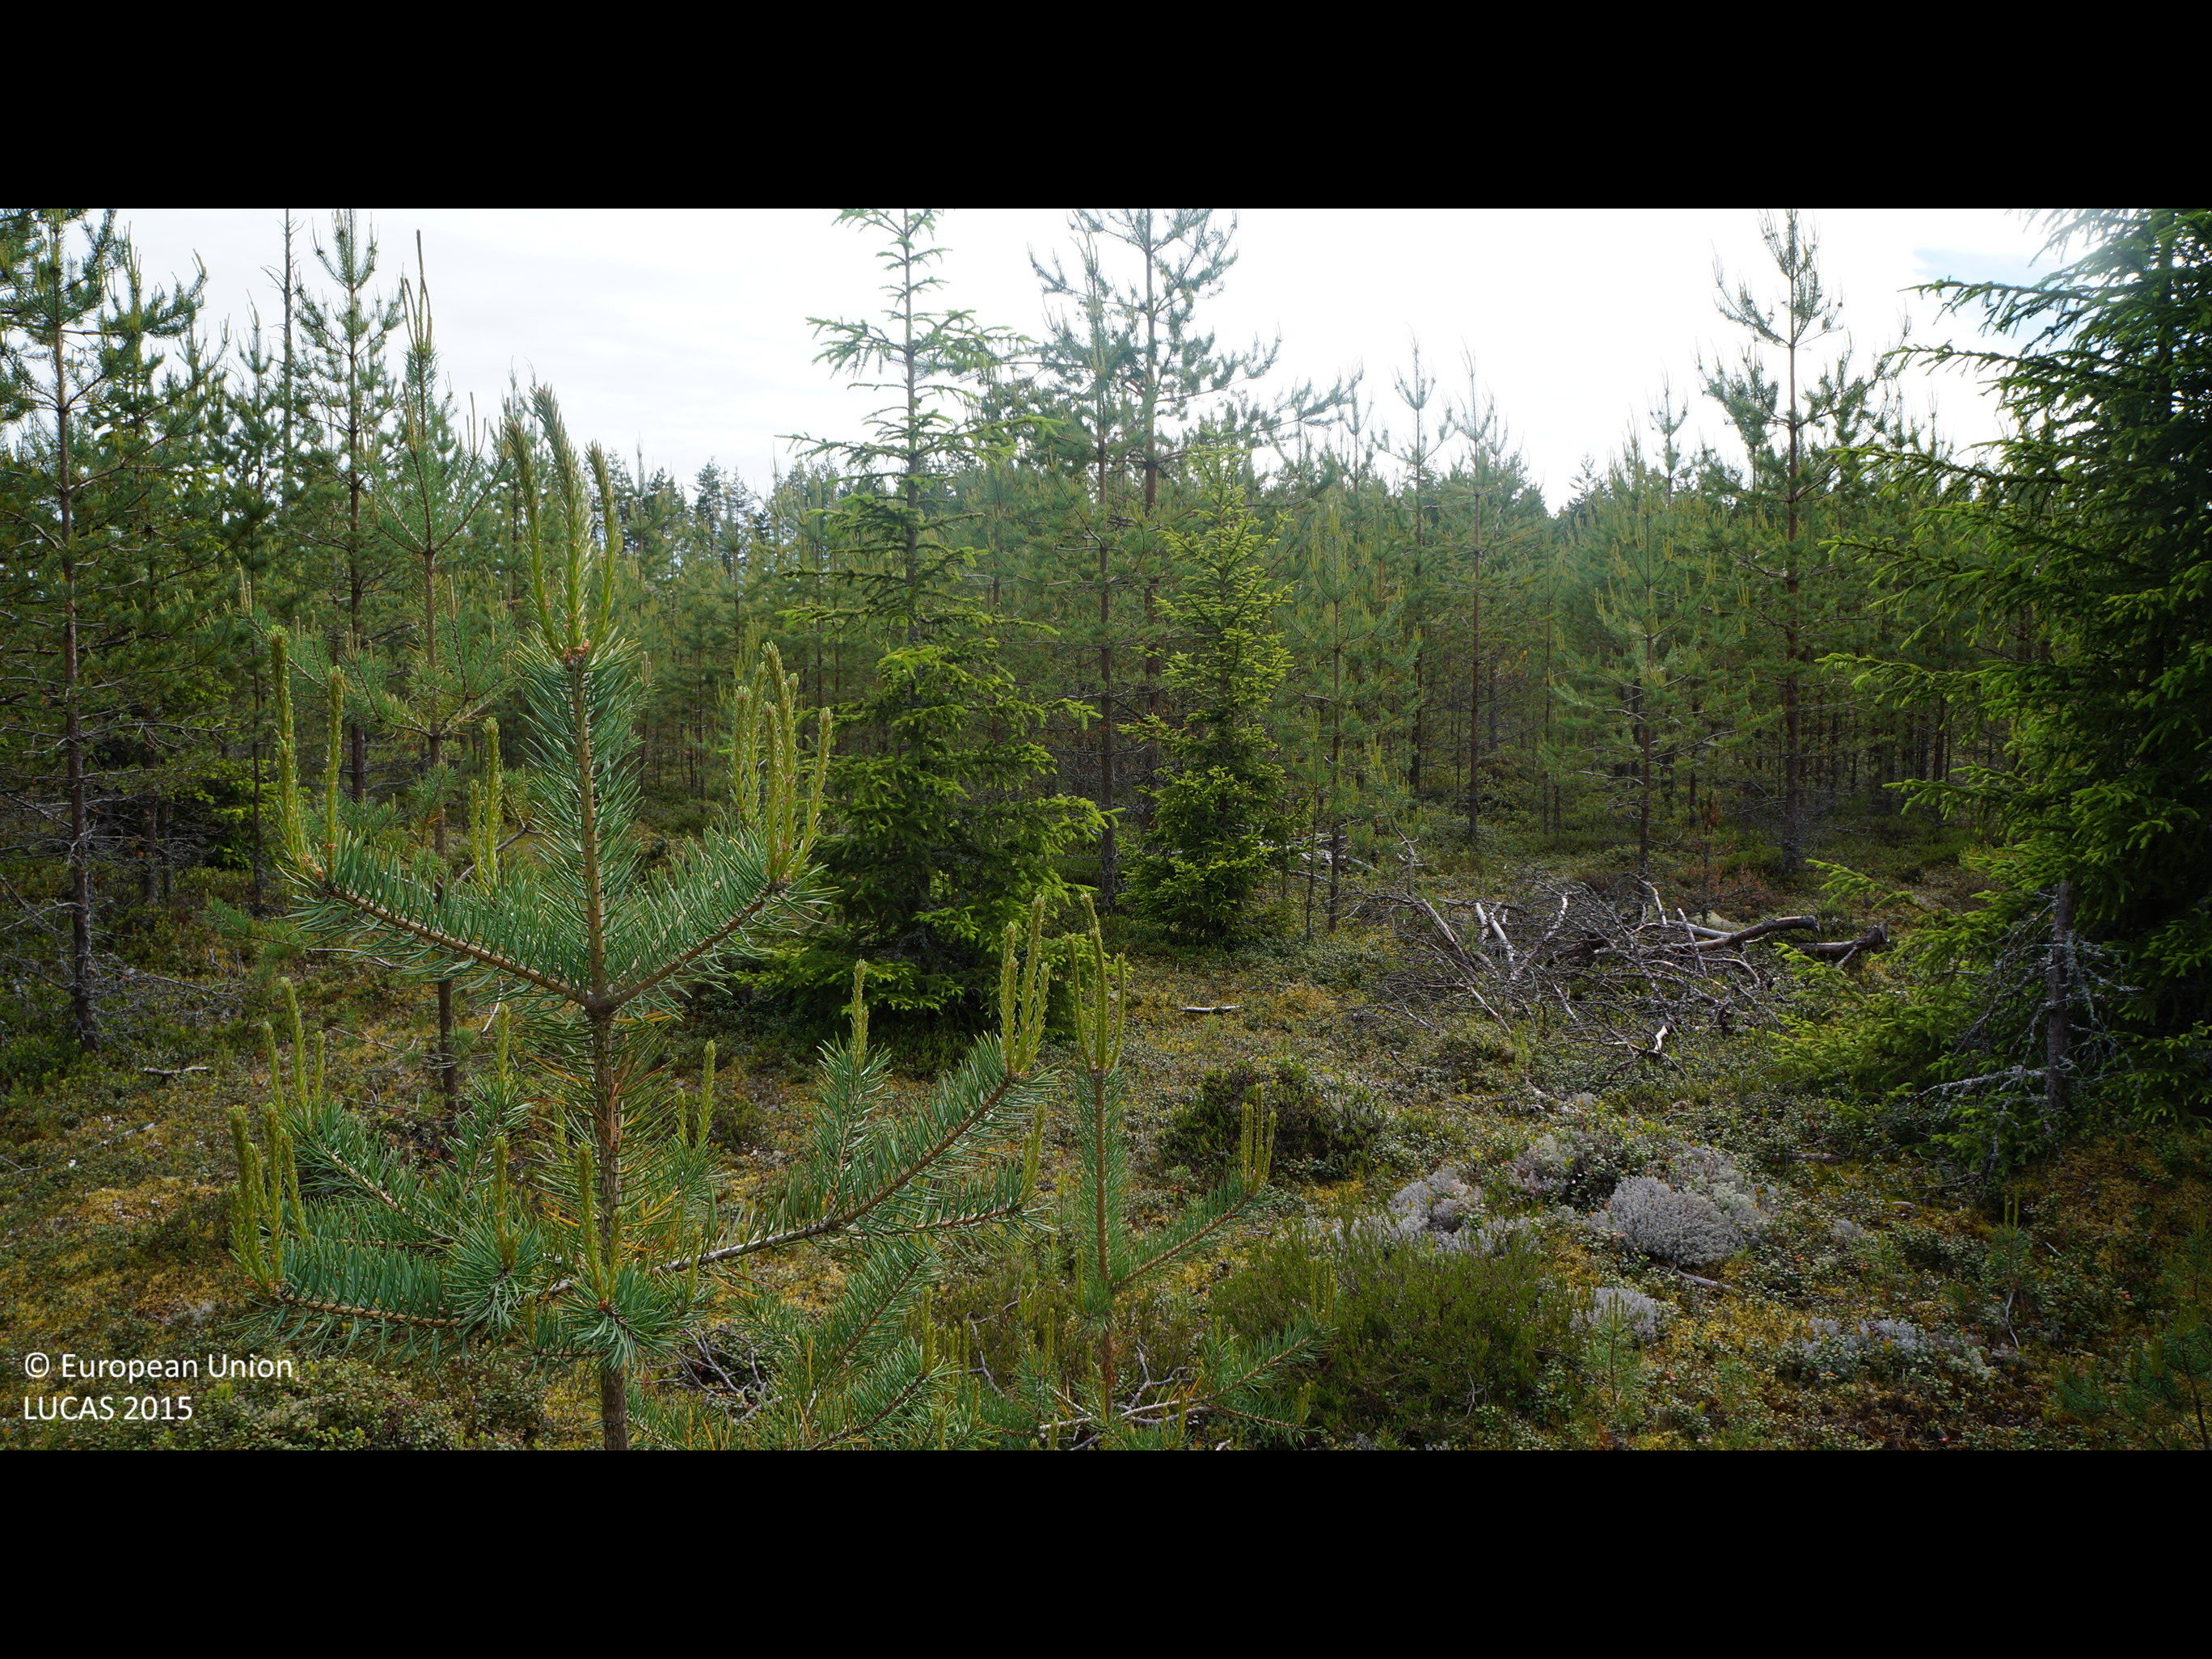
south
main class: Woodland
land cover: Pine dominated coniferous woodland
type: boreal forest
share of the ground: 25 - 50 %
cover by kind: coniferous forest trees 40 %, shrubs 40 %, lichens and mosses 20 %
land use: Forestry
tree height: > 5 m
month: June
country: FI
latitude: 63.8036
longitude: 23.0256
